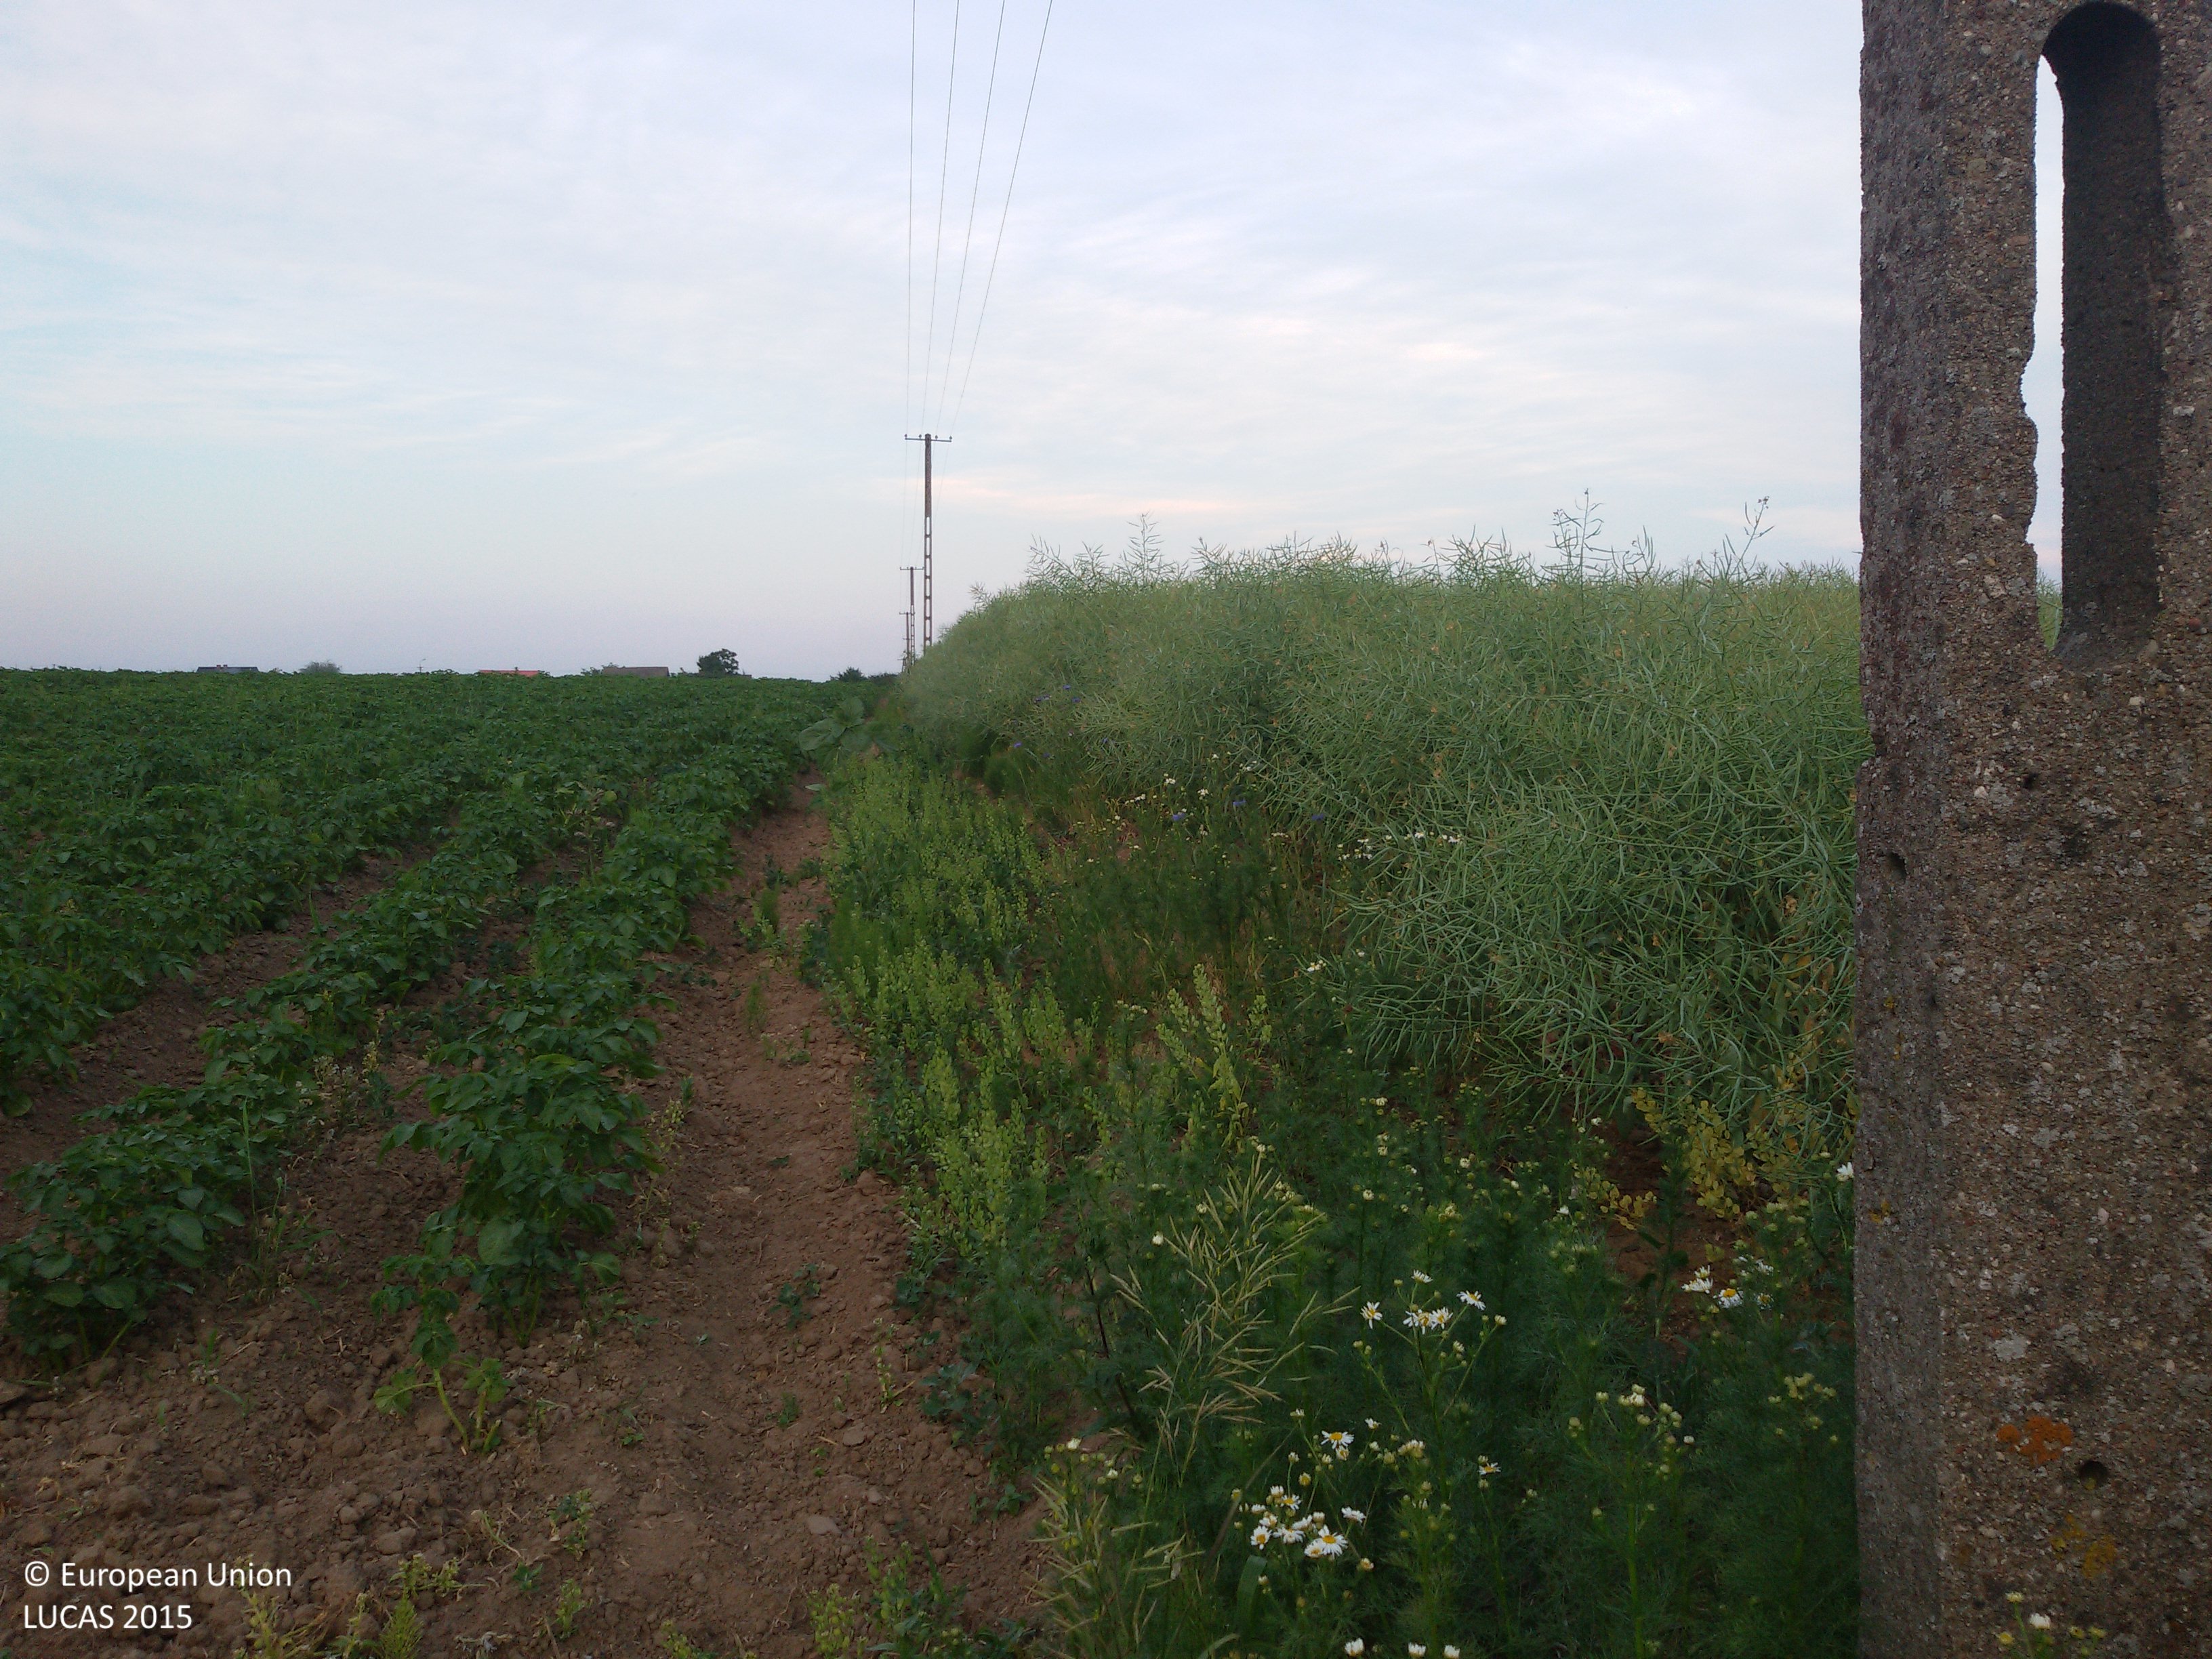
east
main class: Cropland
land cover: Rape and turnip rape
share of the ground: > 75 %
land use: Agriculture (excluding fallow land and kitchen gardens)
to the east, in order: Rape and turnip rape; Electric lines; Potatoes
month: June
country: PL
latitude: 52.5392
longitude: 19.0318
